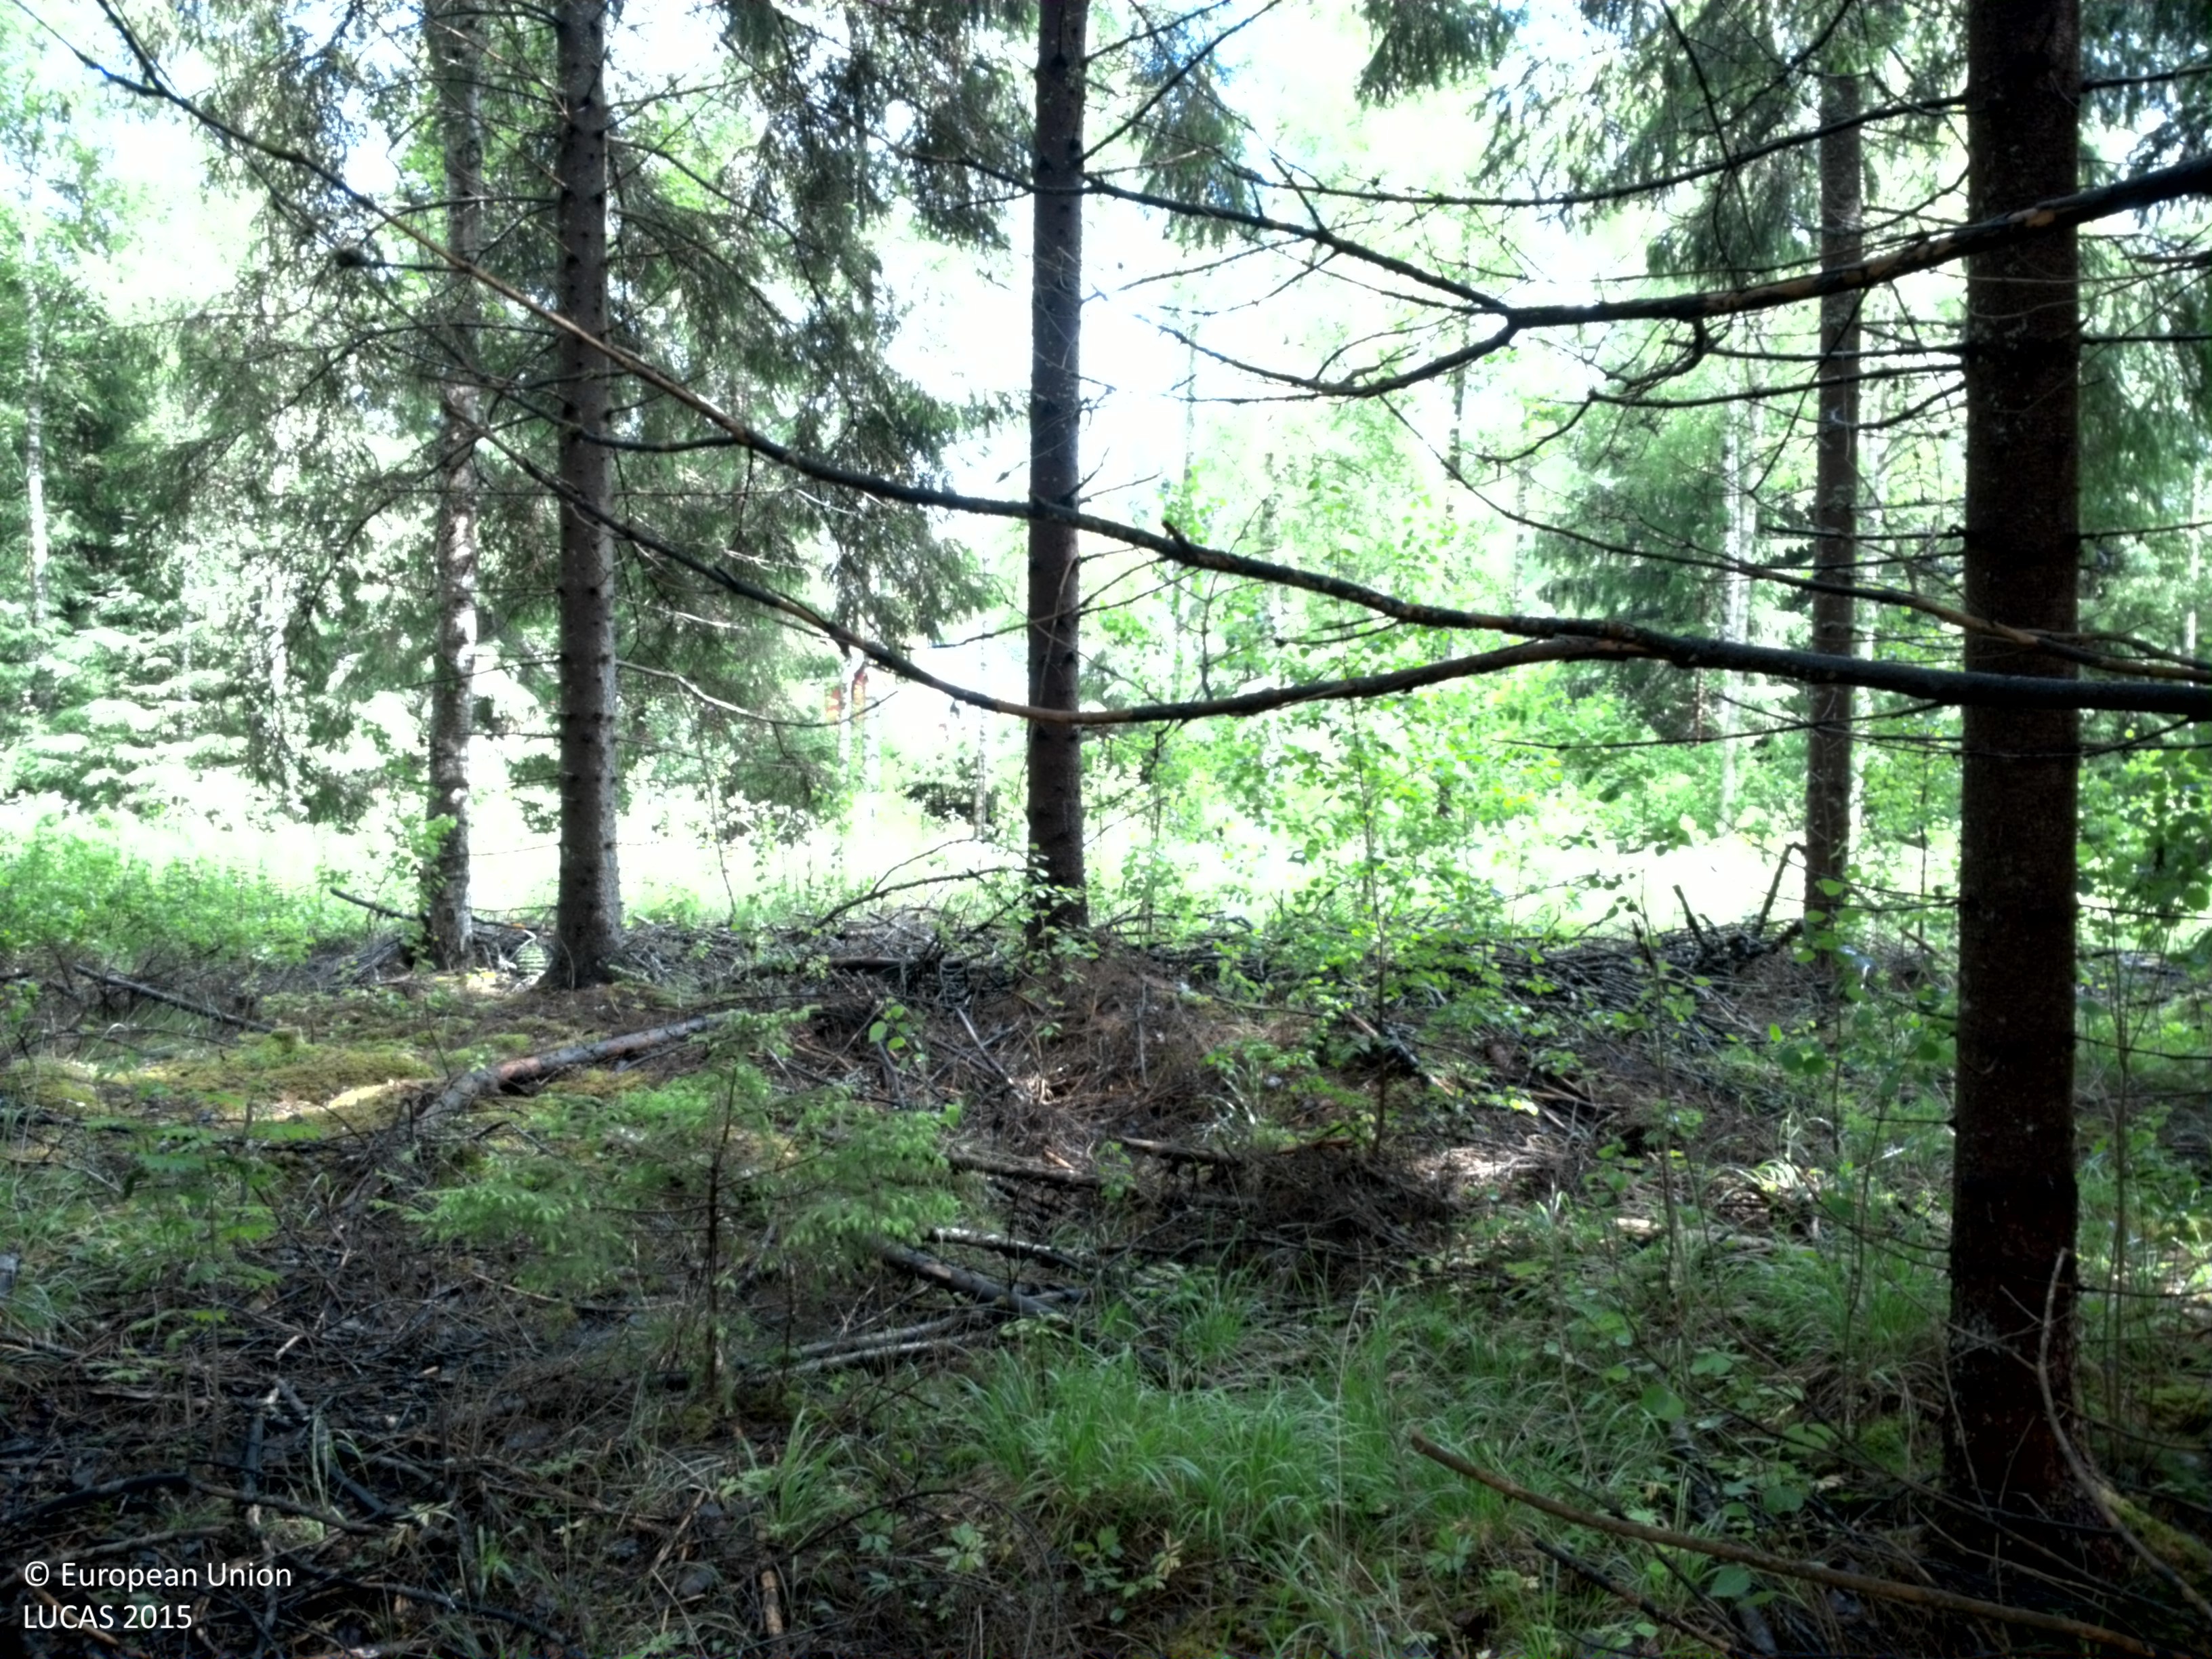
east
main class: Woodland
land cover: Spruce dominated coniferous woodland
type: boreal forest
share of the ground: > 75 %
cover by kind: coniferous forest trees 85 %, broadleaved forest trees 5 %, herbaceous plants 5 %, lichens and mosses 5 %
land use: Forestry
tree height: > 5 m
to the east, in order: Spruce dominated coniferous woodland; Grass margins; Tracks; Grass margins; Broadleaved woodland; Artificial constructions in urban areas
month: June
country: SE
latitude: 59.8581
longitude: 17.0805
